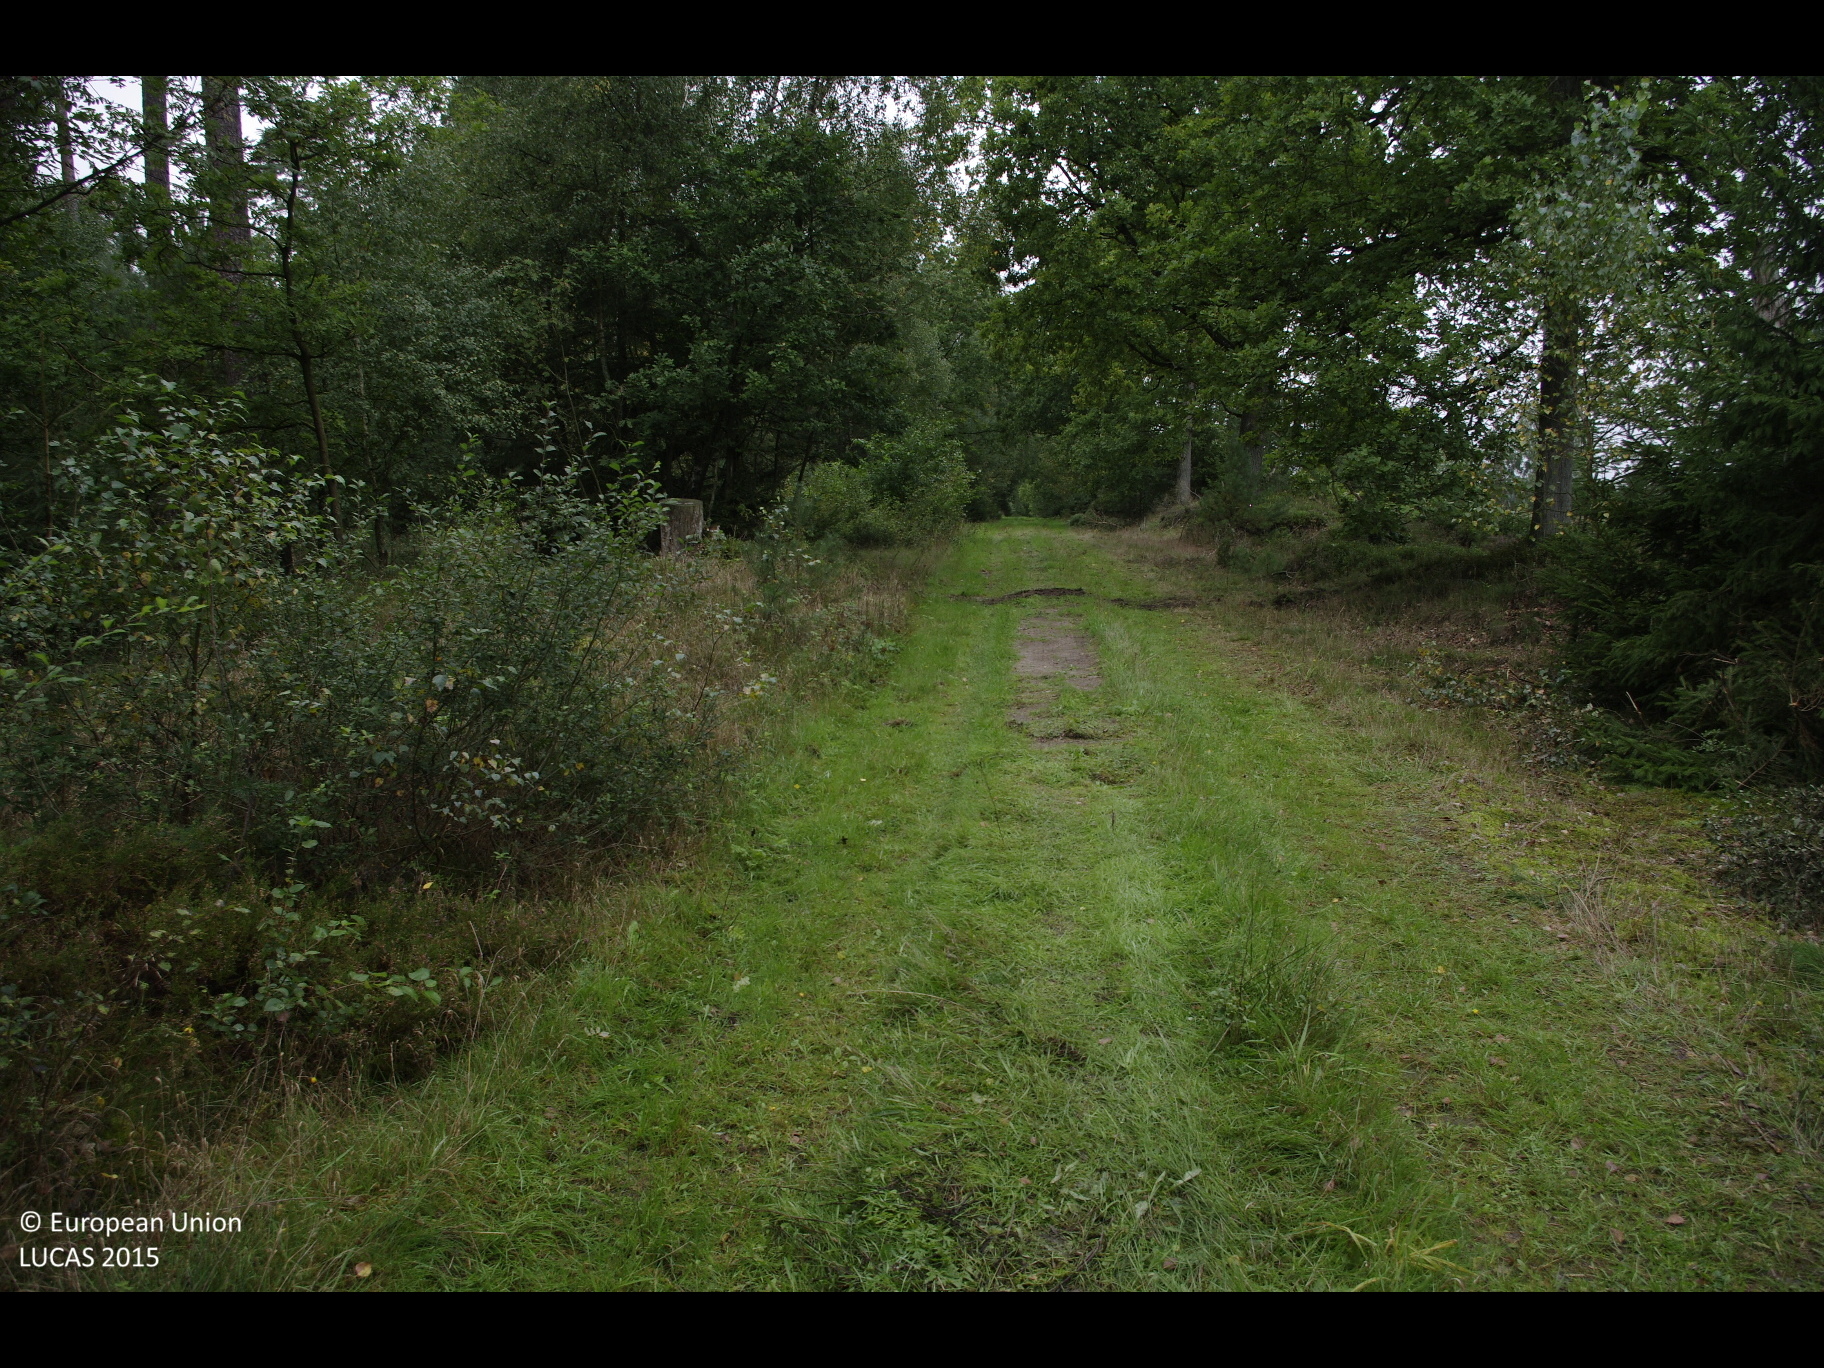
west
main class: Woodland
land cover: Pine dominated mixed woodland
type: hemiboreal forest and nemoral coniferous forest and mixed broadleaved-coniferous forest
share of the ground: > 75 %
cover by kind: coniferous forest trees 50 %, broadleaved forest trees 30 %, herbaceous plants 20 %
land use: Forestry
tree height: > 5 m
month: September
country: DE
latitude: 53.0964
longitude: 9.9254
